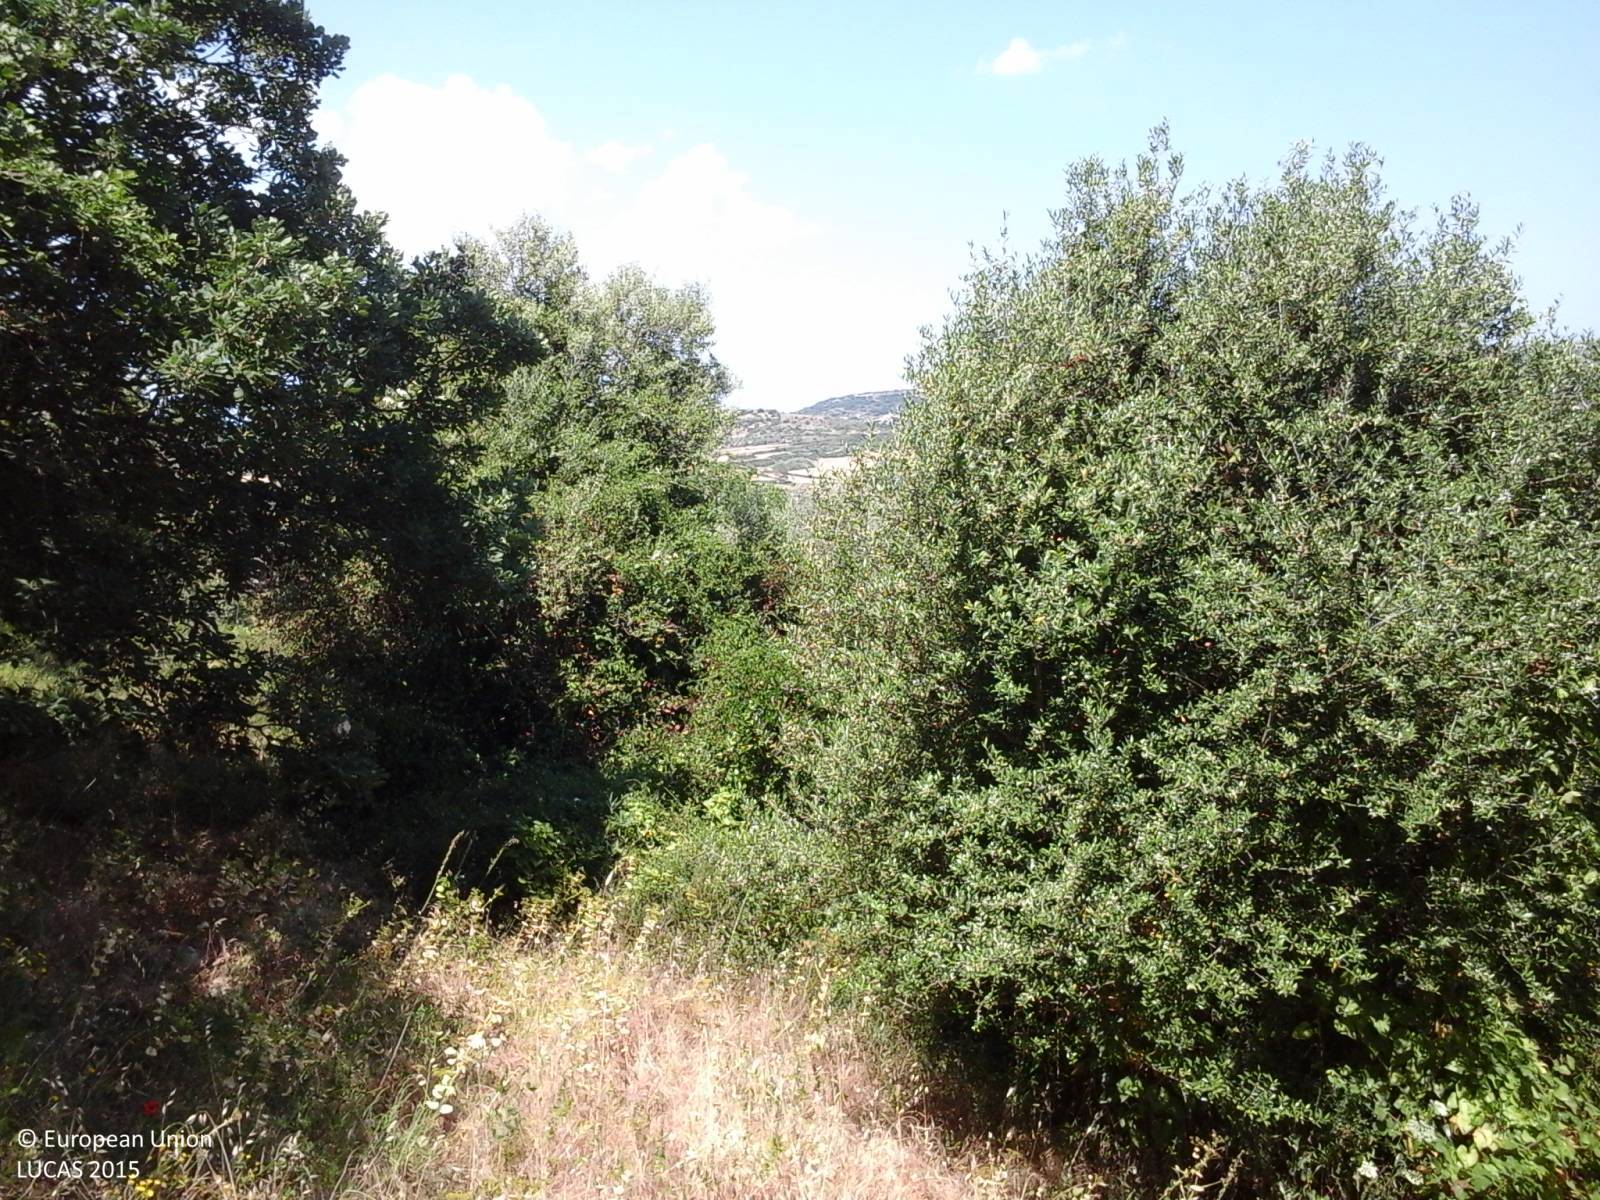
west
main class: Shrubland
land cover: Shrubland with sparse tree cover
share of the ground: 50 - 75 %
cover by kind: shrubs 60 %, herbaceous plants 30 %, broadleaved forest trees 5 %, consolidated bare surface 5 %
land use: Agriculture (excluding fallow land and kitchen gardens)
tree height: < 5 m
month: June
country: IT
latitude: 40.6384
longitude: 8.6704
